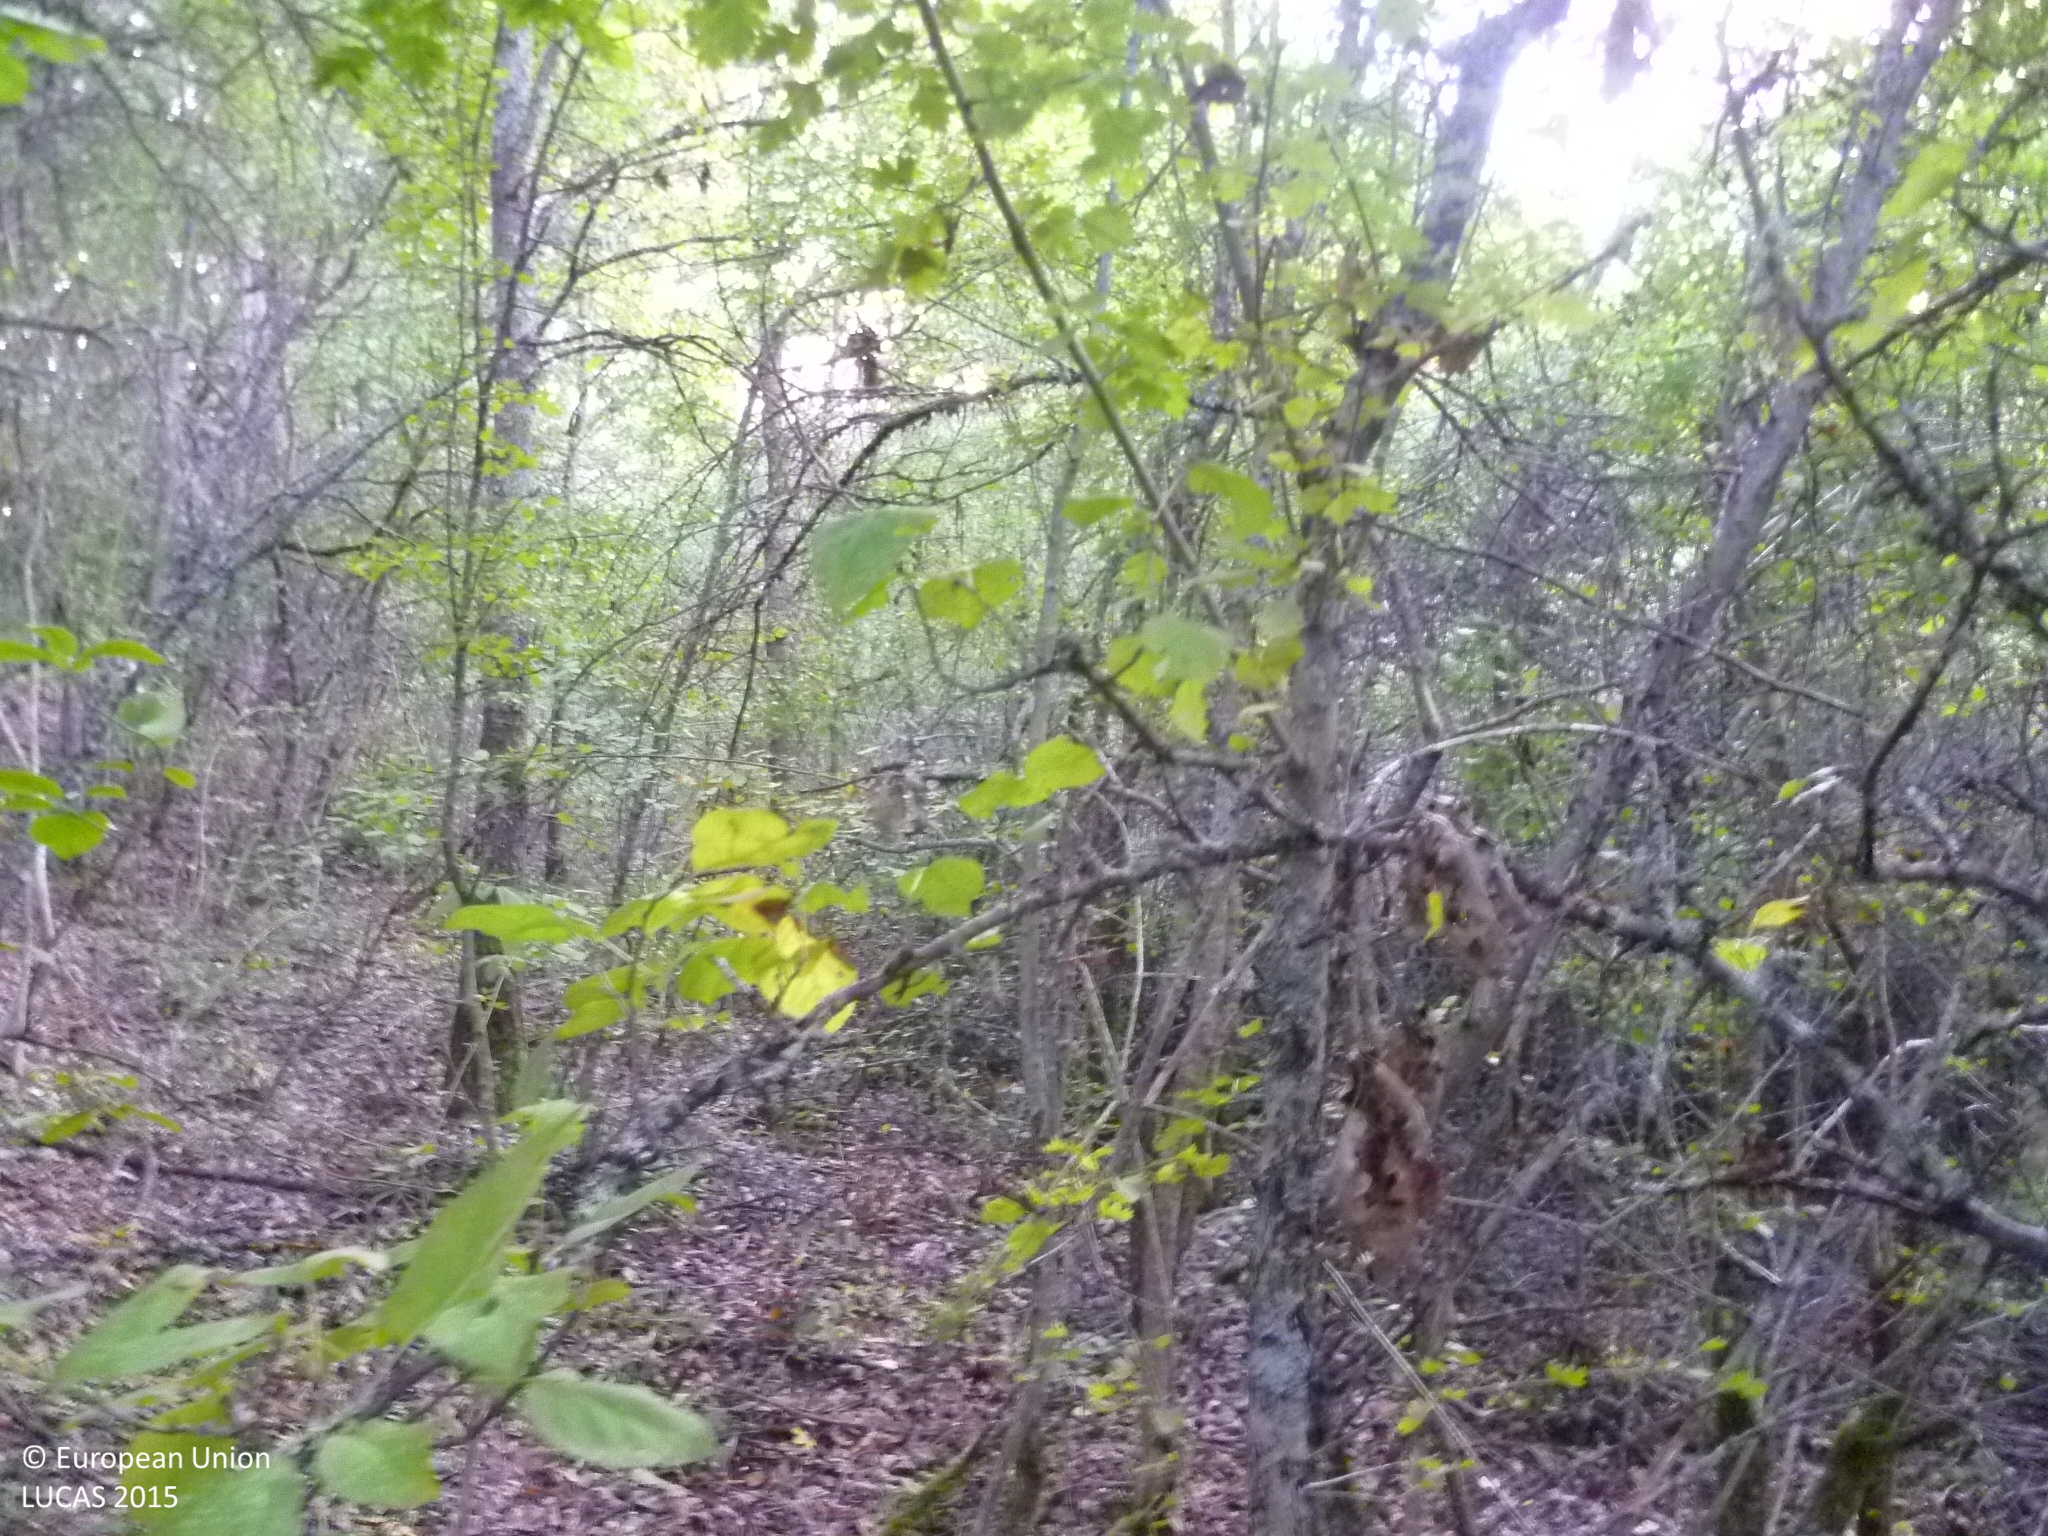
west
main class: Woodland
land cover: Broadleaved woodland
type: mesophytic deciduous forest
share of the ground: 50 - 75 %
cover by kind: broadleaved forest trees 60 %, unconsolidated bare surface 30 %, shrubs 5 %, lichens and mosses 5 %
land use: Forestry
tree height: > 5 m
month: October
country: BG
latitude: 42.8234
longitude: 22.6619
